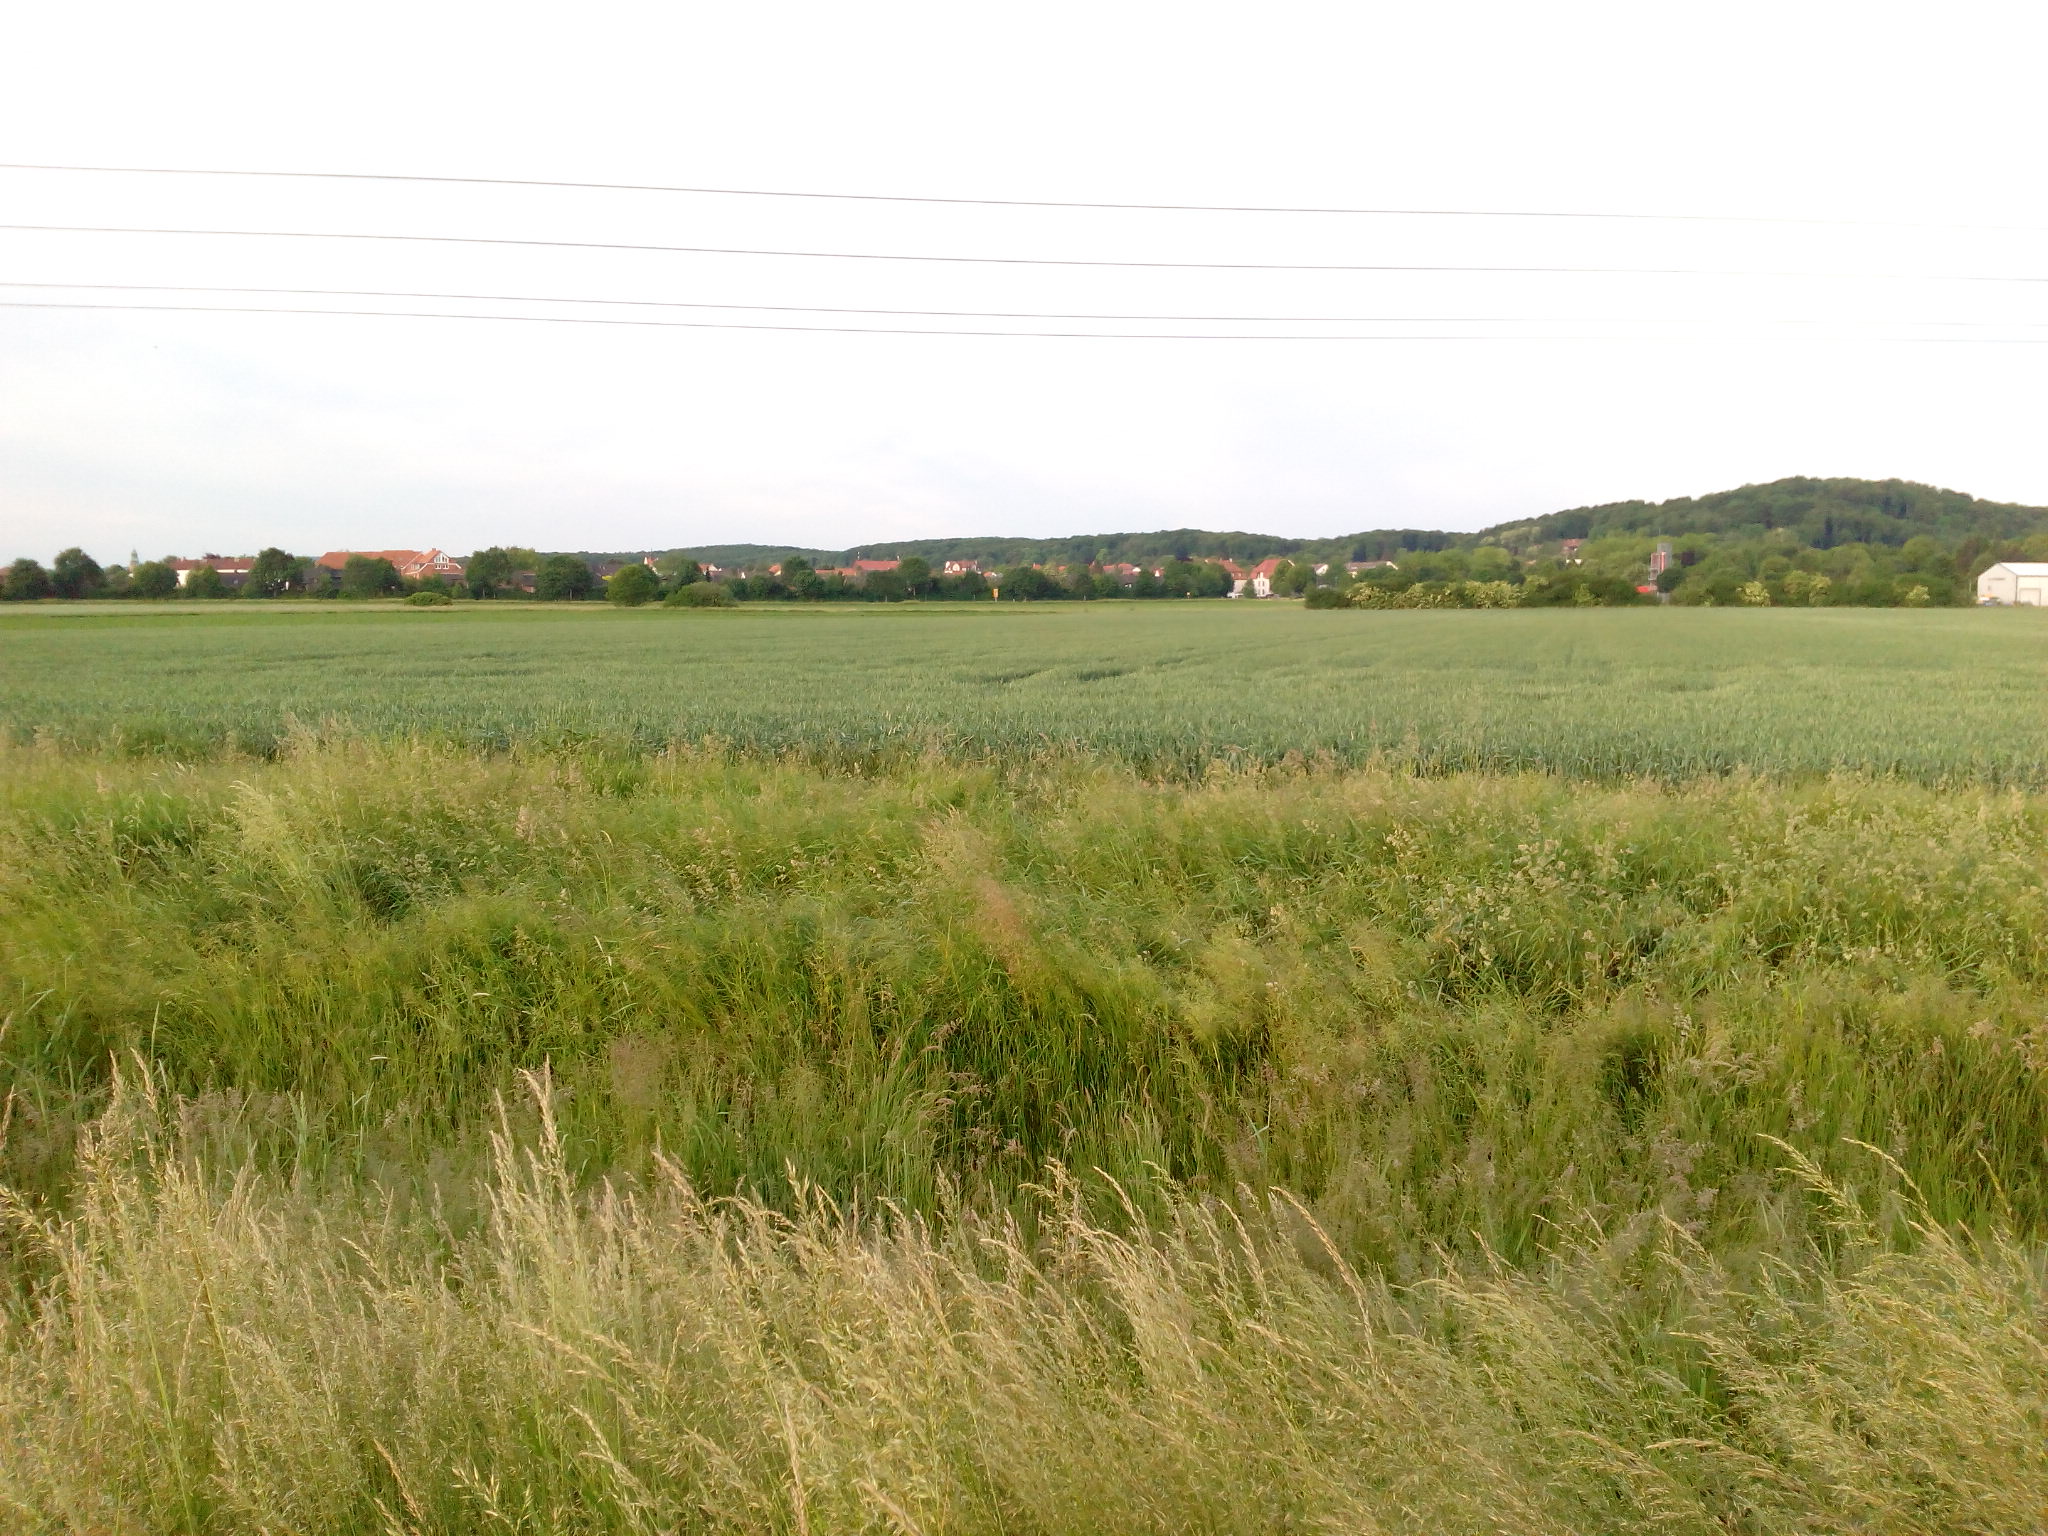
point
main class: Cropland
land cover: Common wheat
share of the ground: > 75 %
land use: Agriculture (excluding fallow land and kitchen gardens)
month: June
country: DE
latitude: 52.3229
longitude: 9.6040
